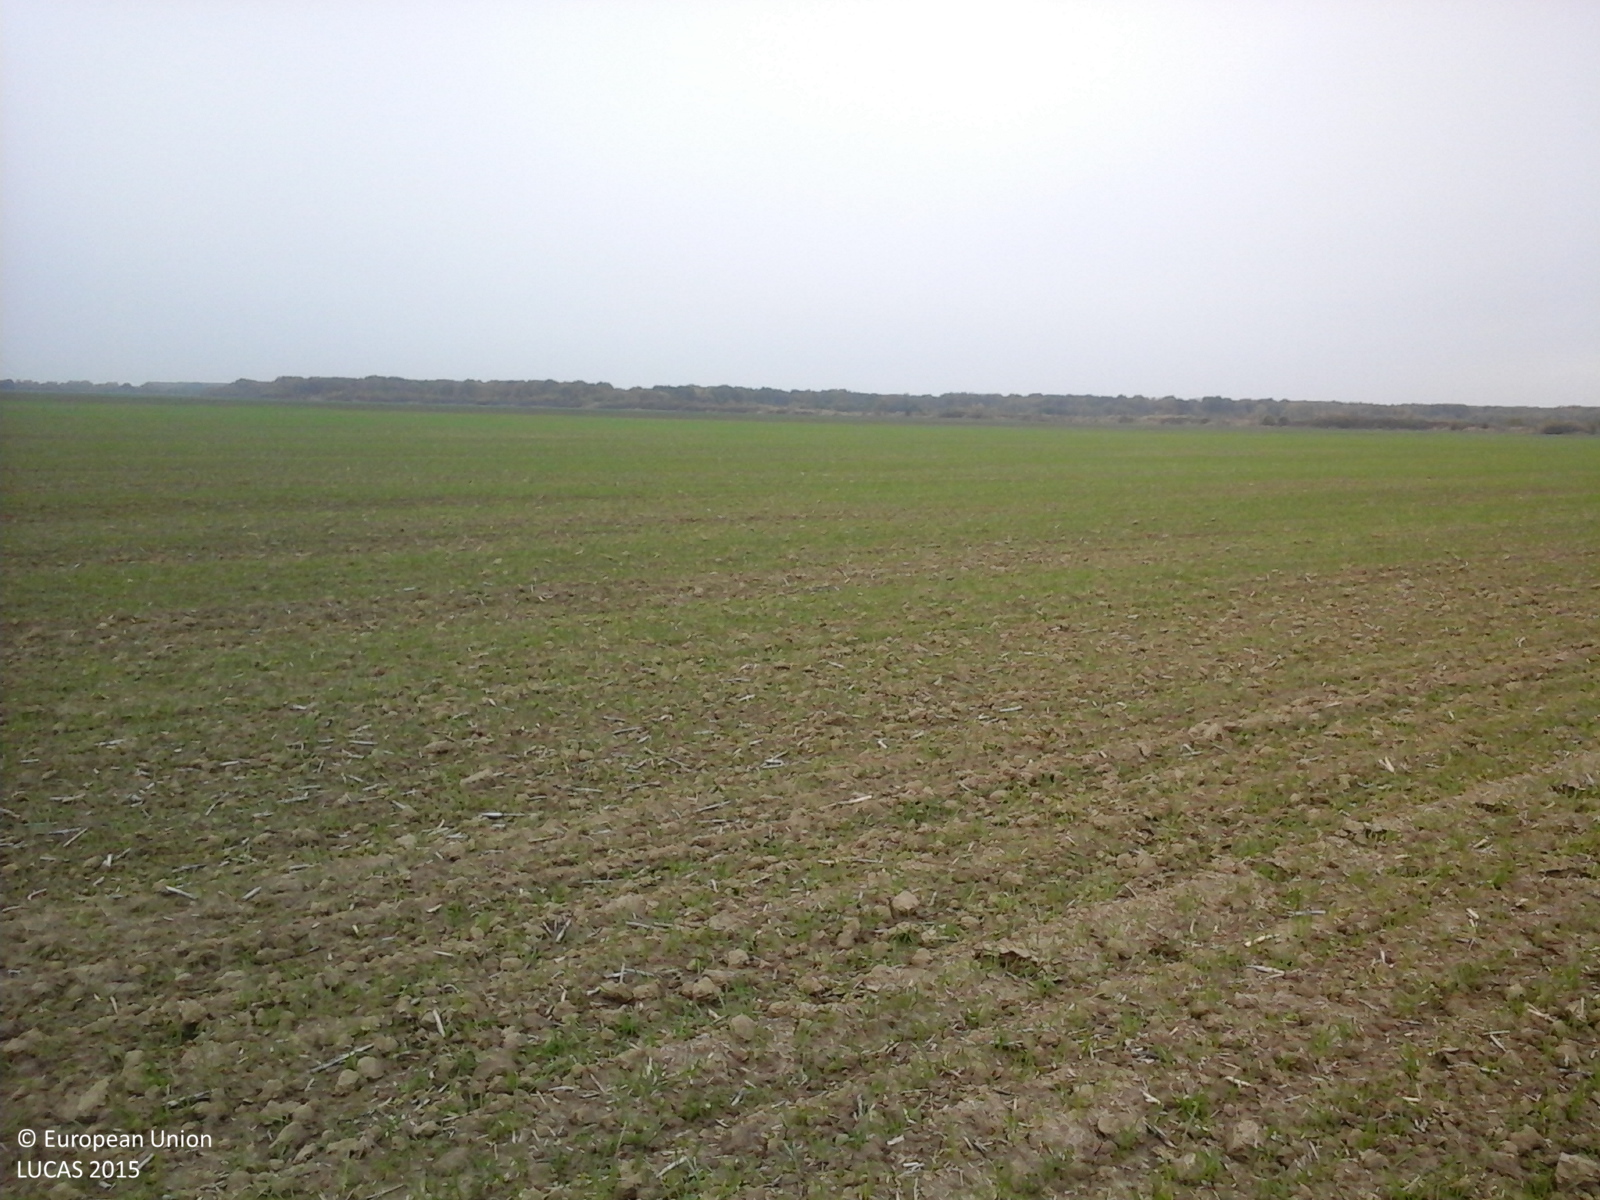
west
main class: Cropland
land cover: Common wheat
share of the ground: 25 - 50 %
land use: Agriculture (excluding fallow land and kitchen gardens)
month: October
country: RO
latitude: 44.8264
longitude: 26.3420
